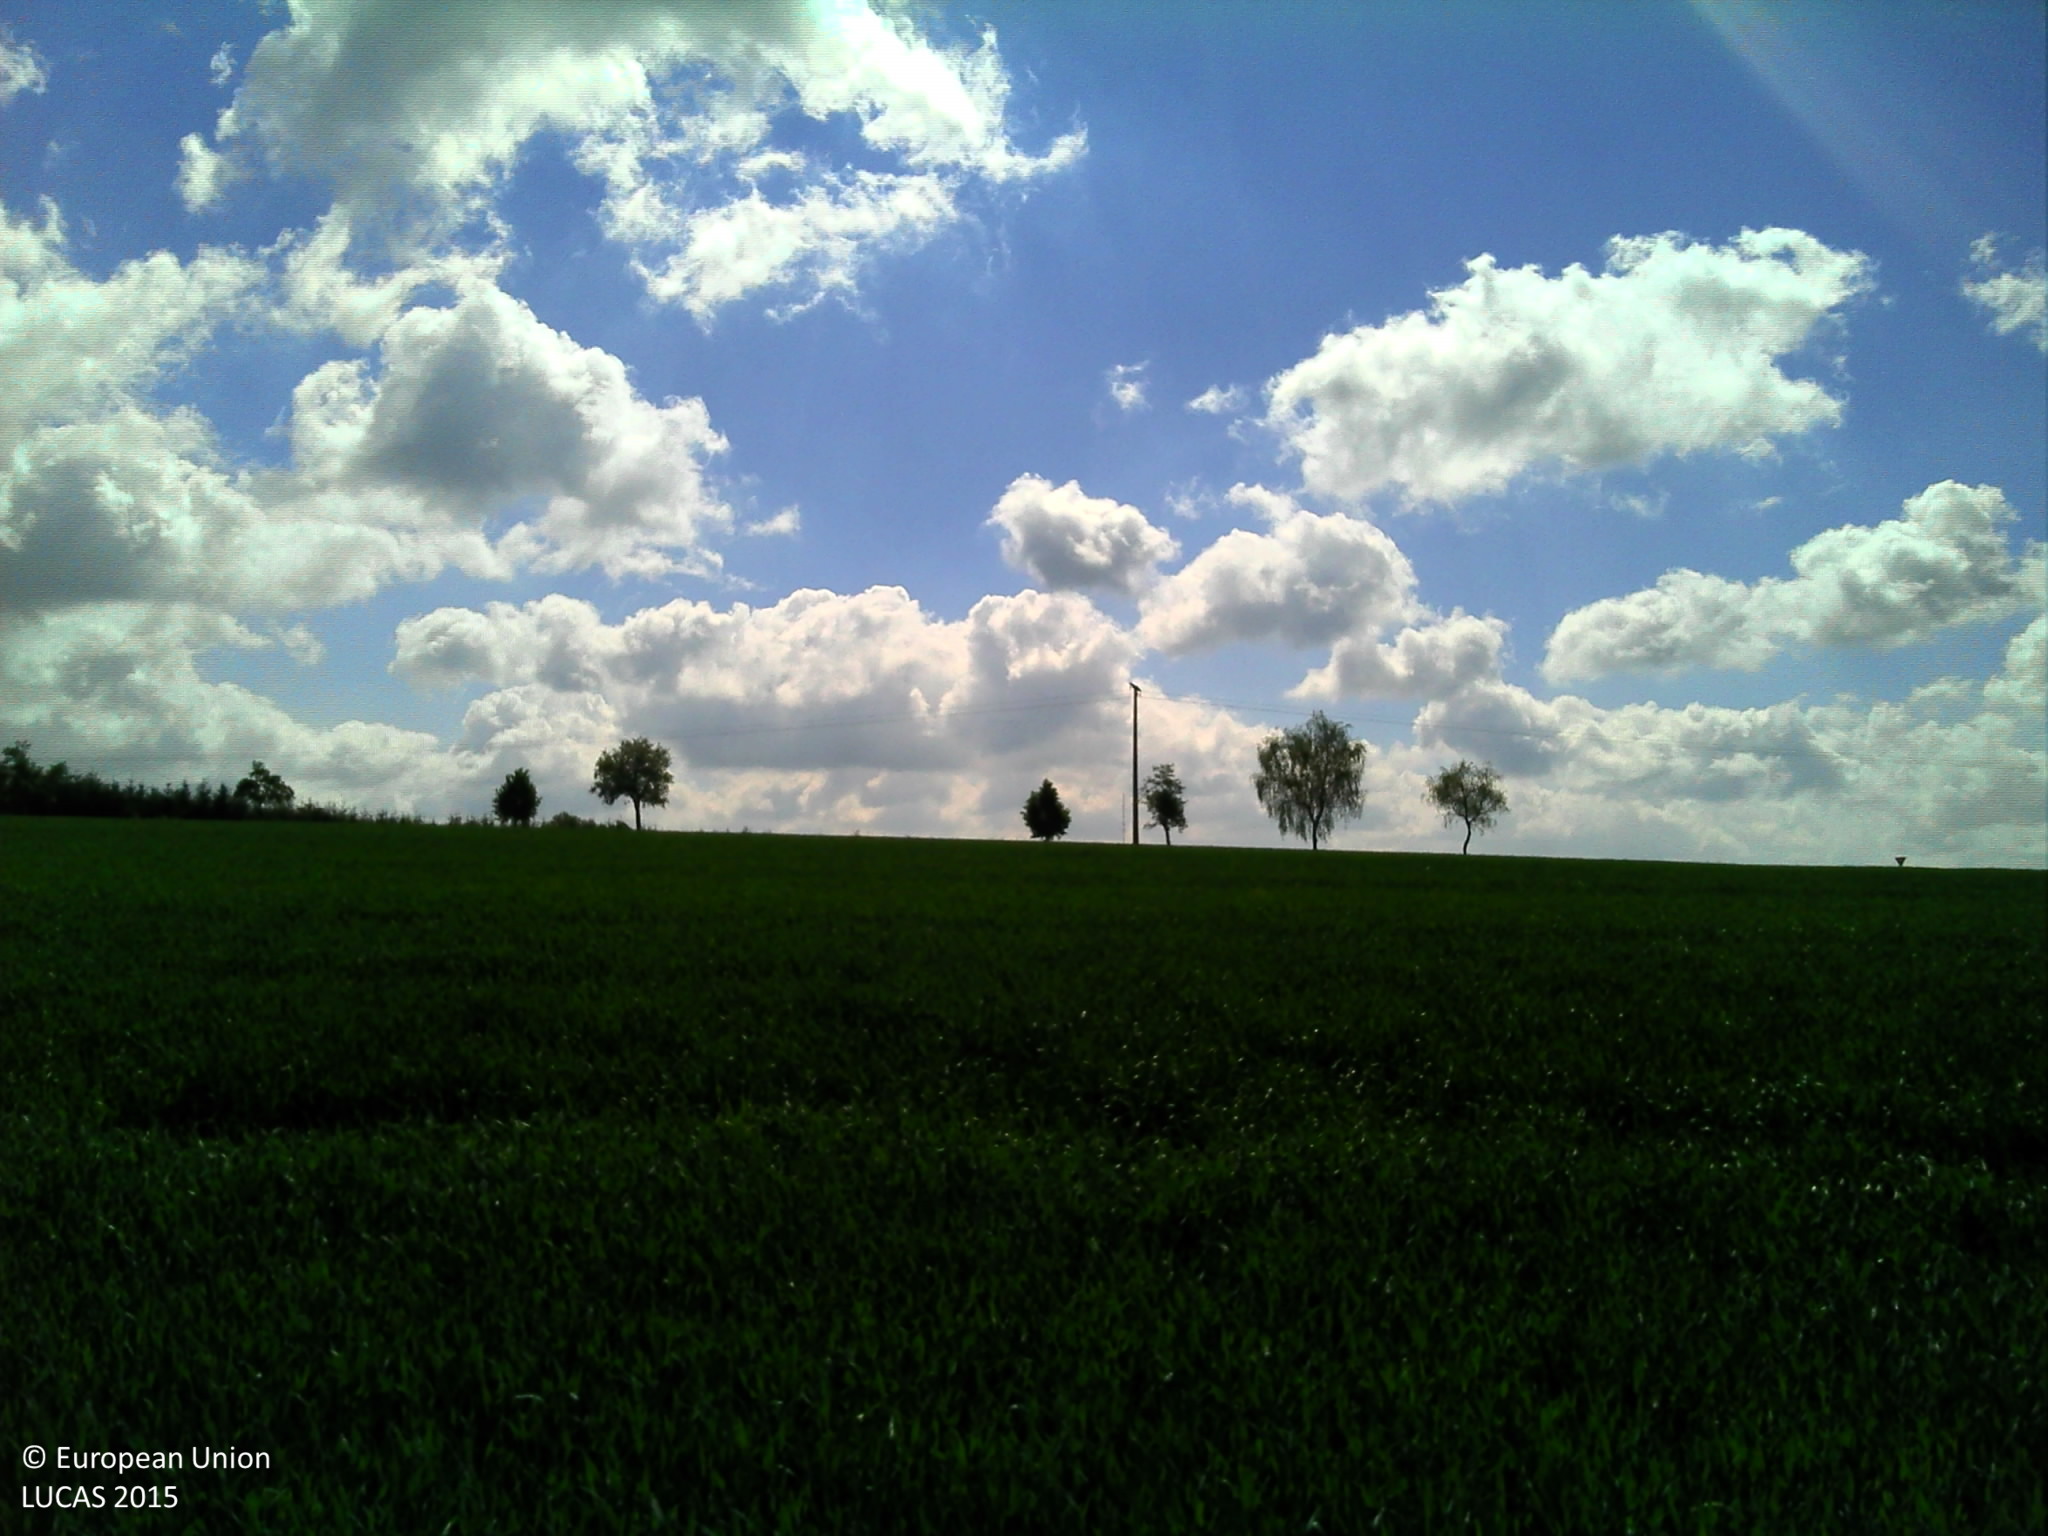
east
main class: Cropland
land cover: Common wheat
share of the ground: > 75 %
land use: Agriculture (excluding fallow land and kitchen gardens)
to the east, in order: Common wheat; Lines of trees; Electric lines; Grass margins; Paved roads, cycling and walking lanes; Grass margins; Common wheat; Tracks; Common wheat; Shruby margins; Spruce dominated coniferous woodland
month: May
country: LU
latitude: 50.0438
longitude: 6.0474
